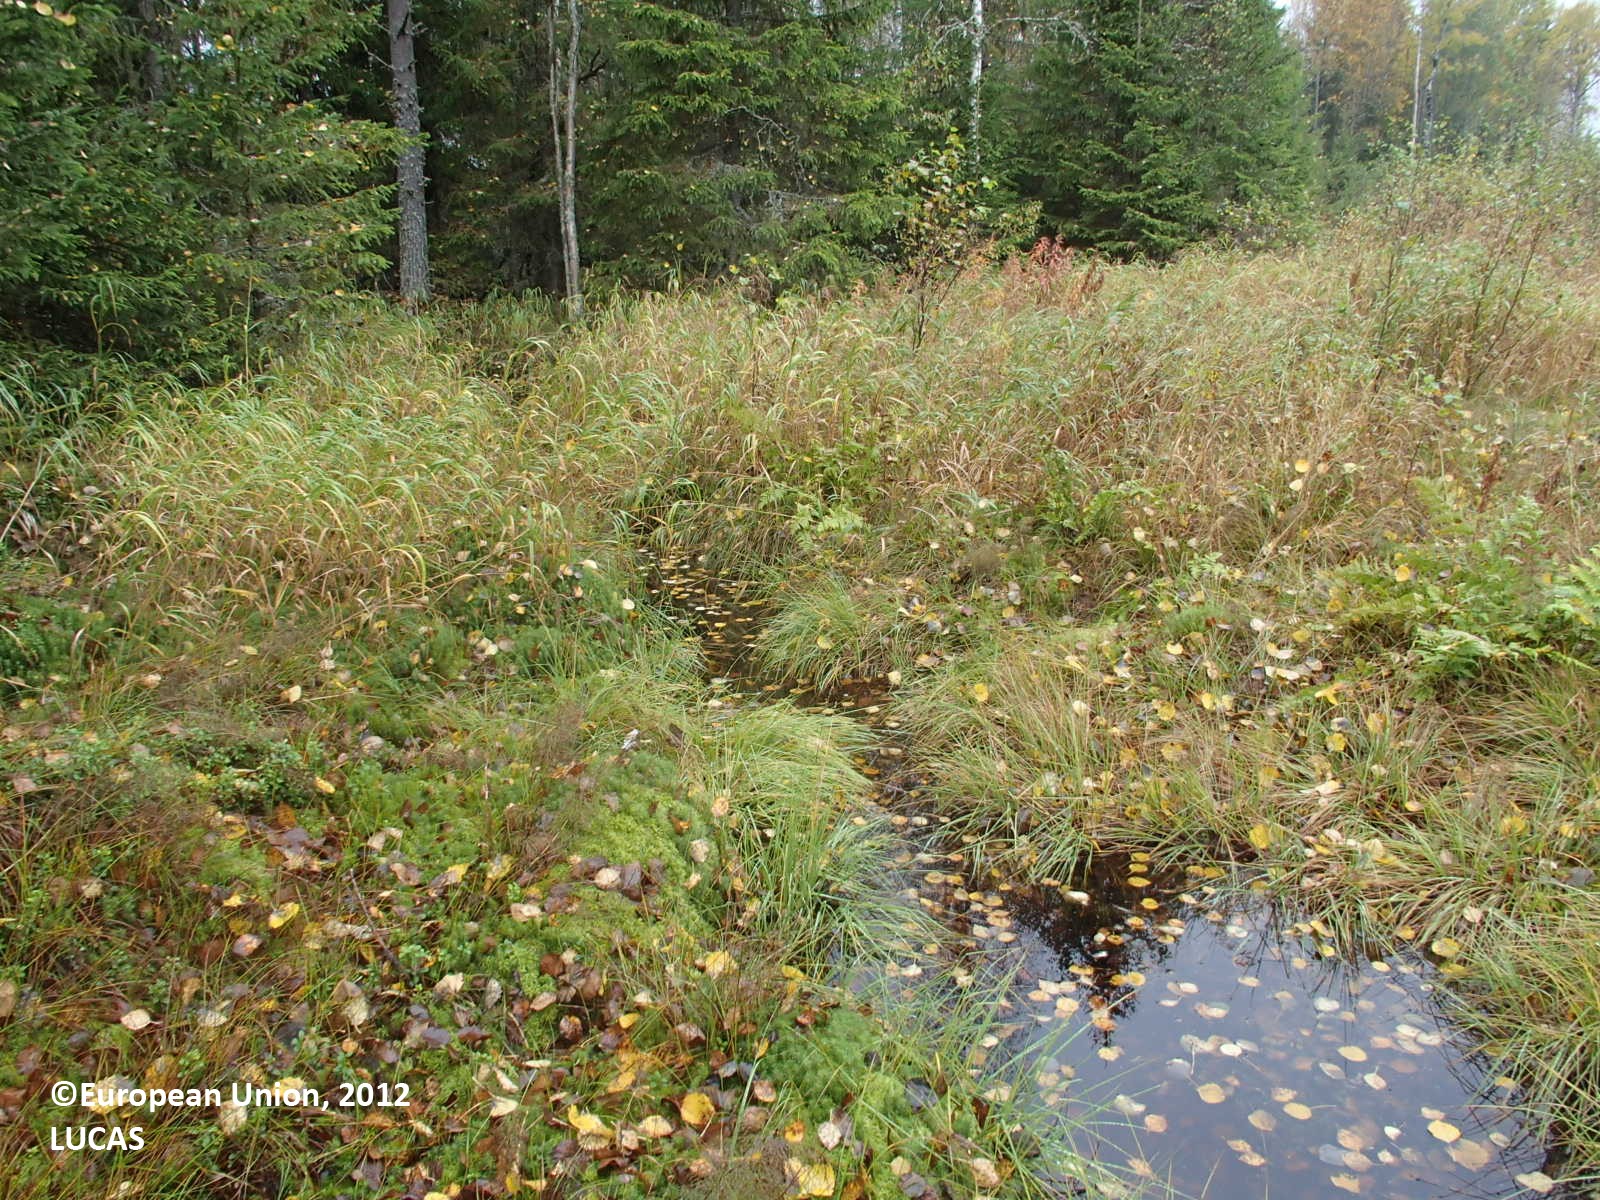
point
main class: Grassland
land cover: Spontaneously vegetated surfaces
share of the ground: > 75 %
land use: Fallow land
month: September
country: FI
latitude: 63.8249
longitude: 26.8132
